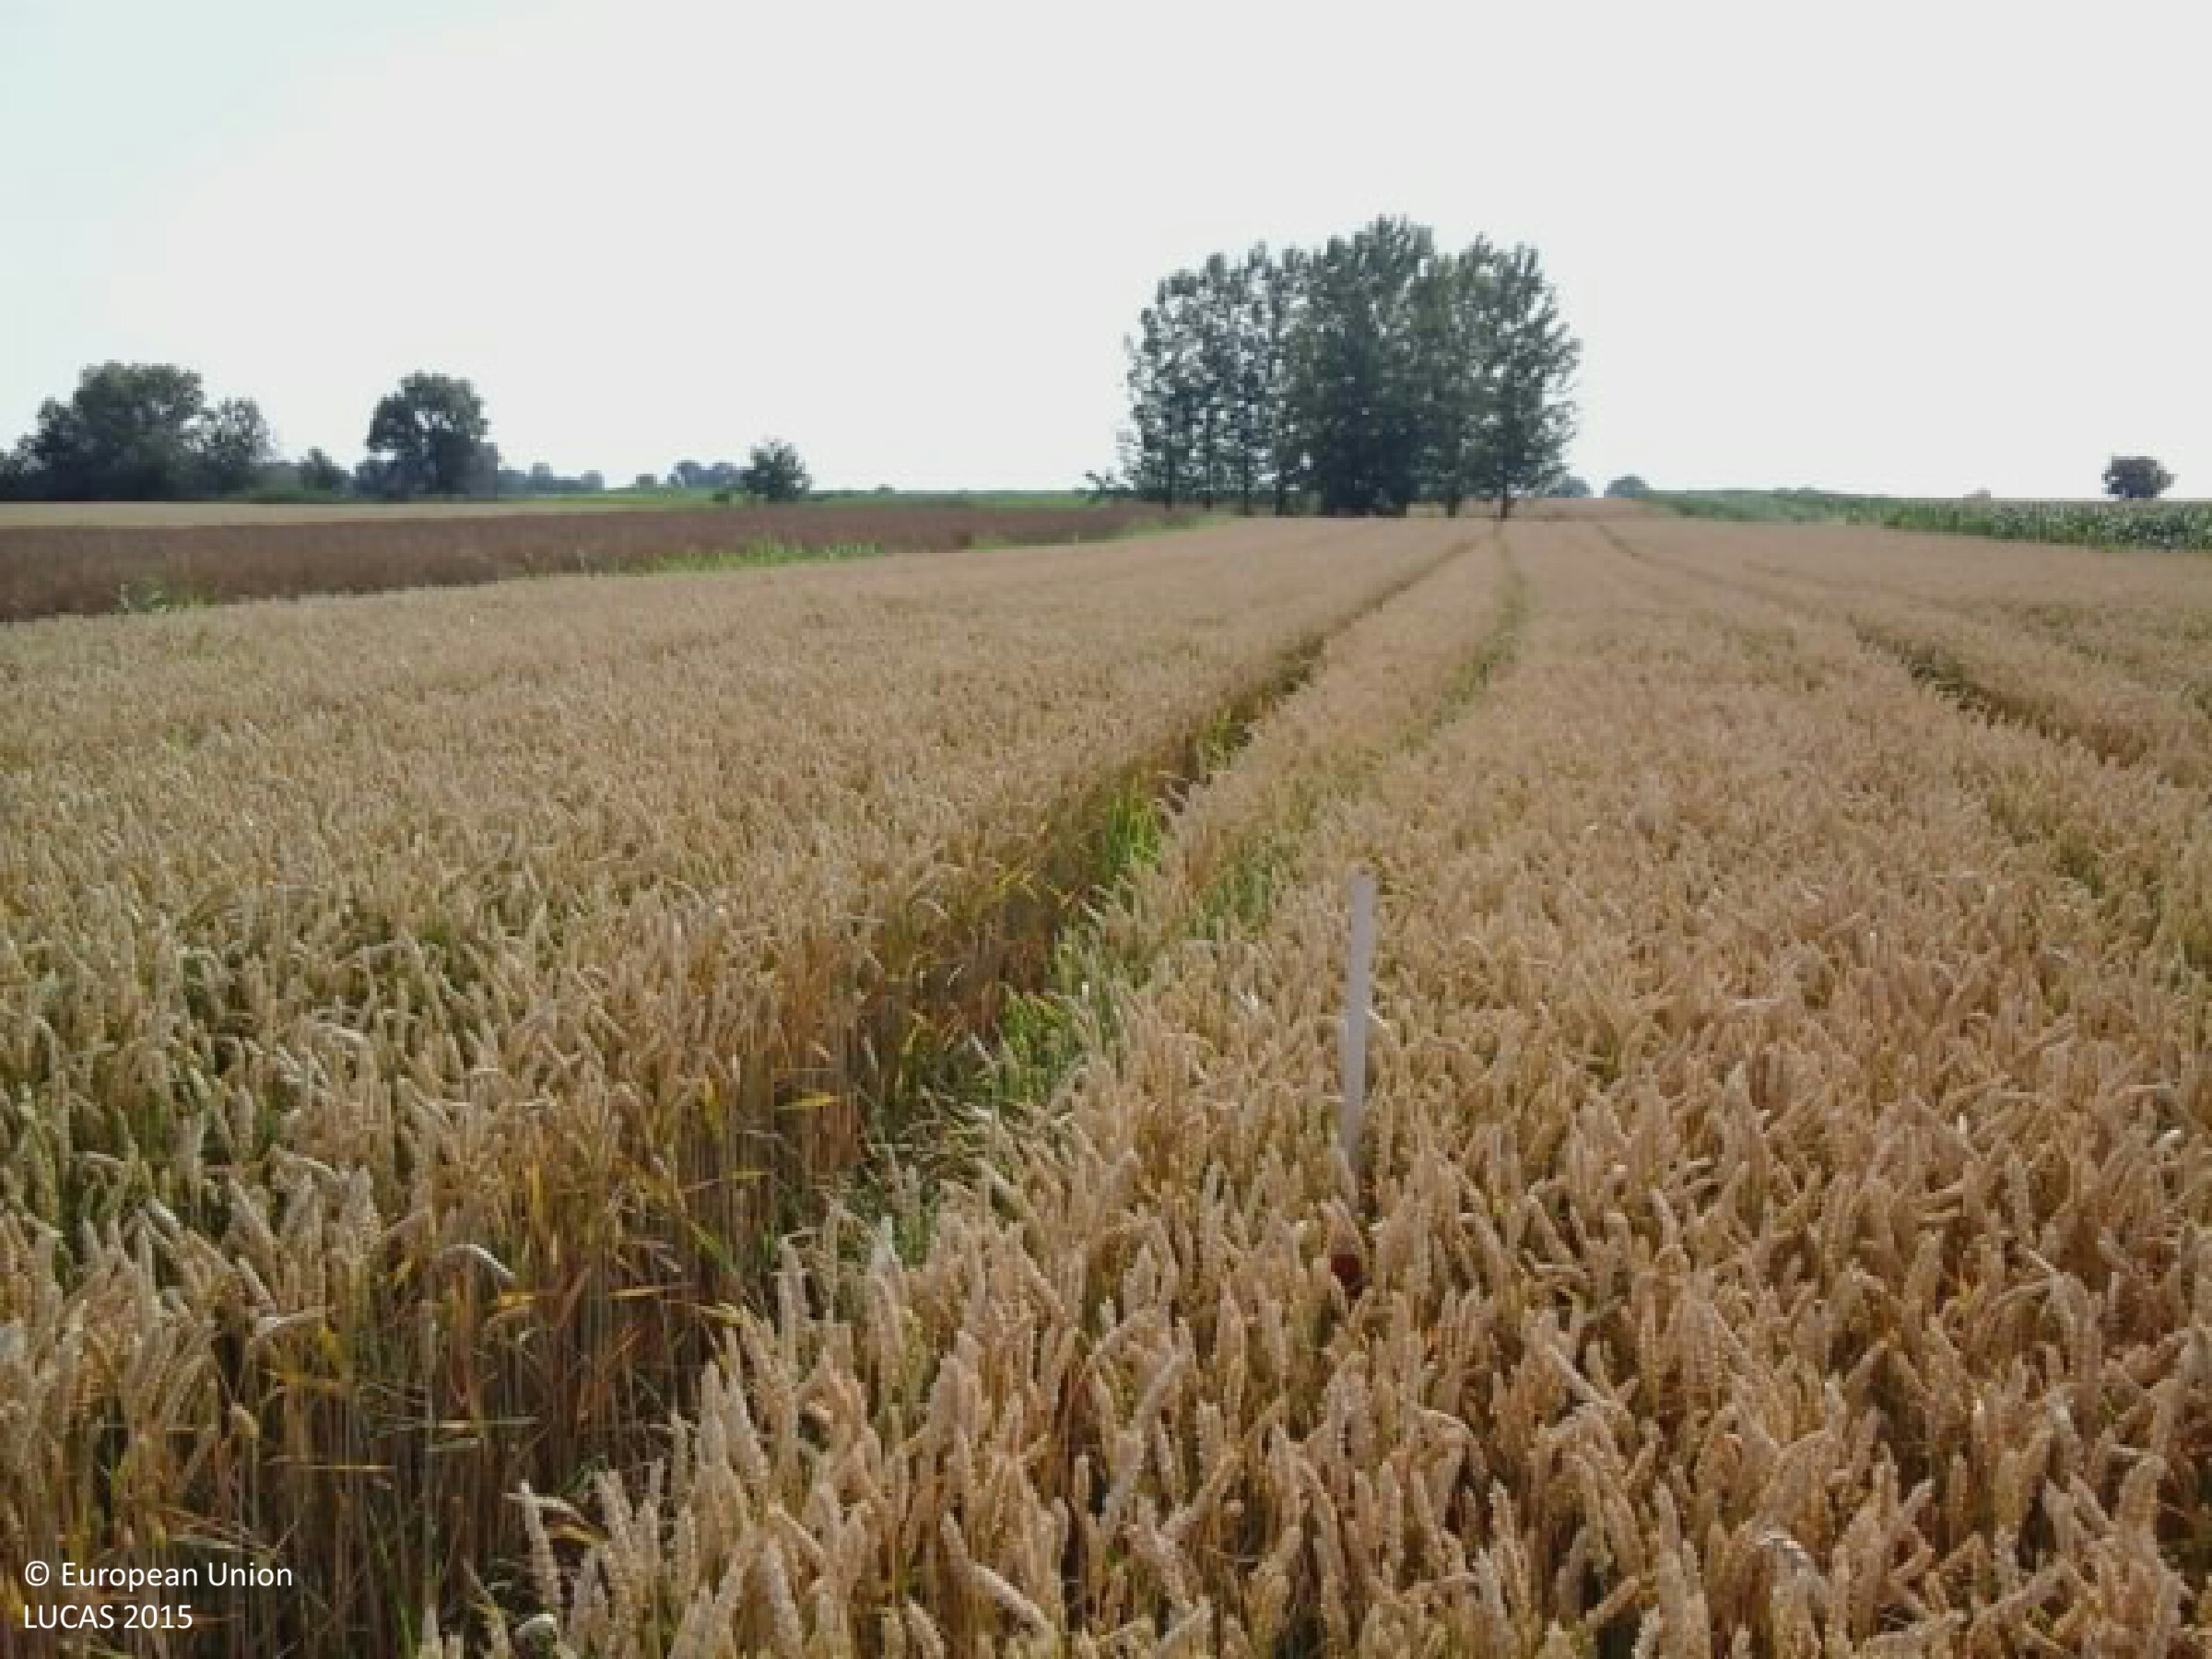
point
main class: Cropland
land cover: Common wheat
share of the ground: > 75 %
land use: Agriculture (excluding fallow land and kitchen gardens)
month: June
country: HU
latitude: 46.3723
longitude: 18.9698
